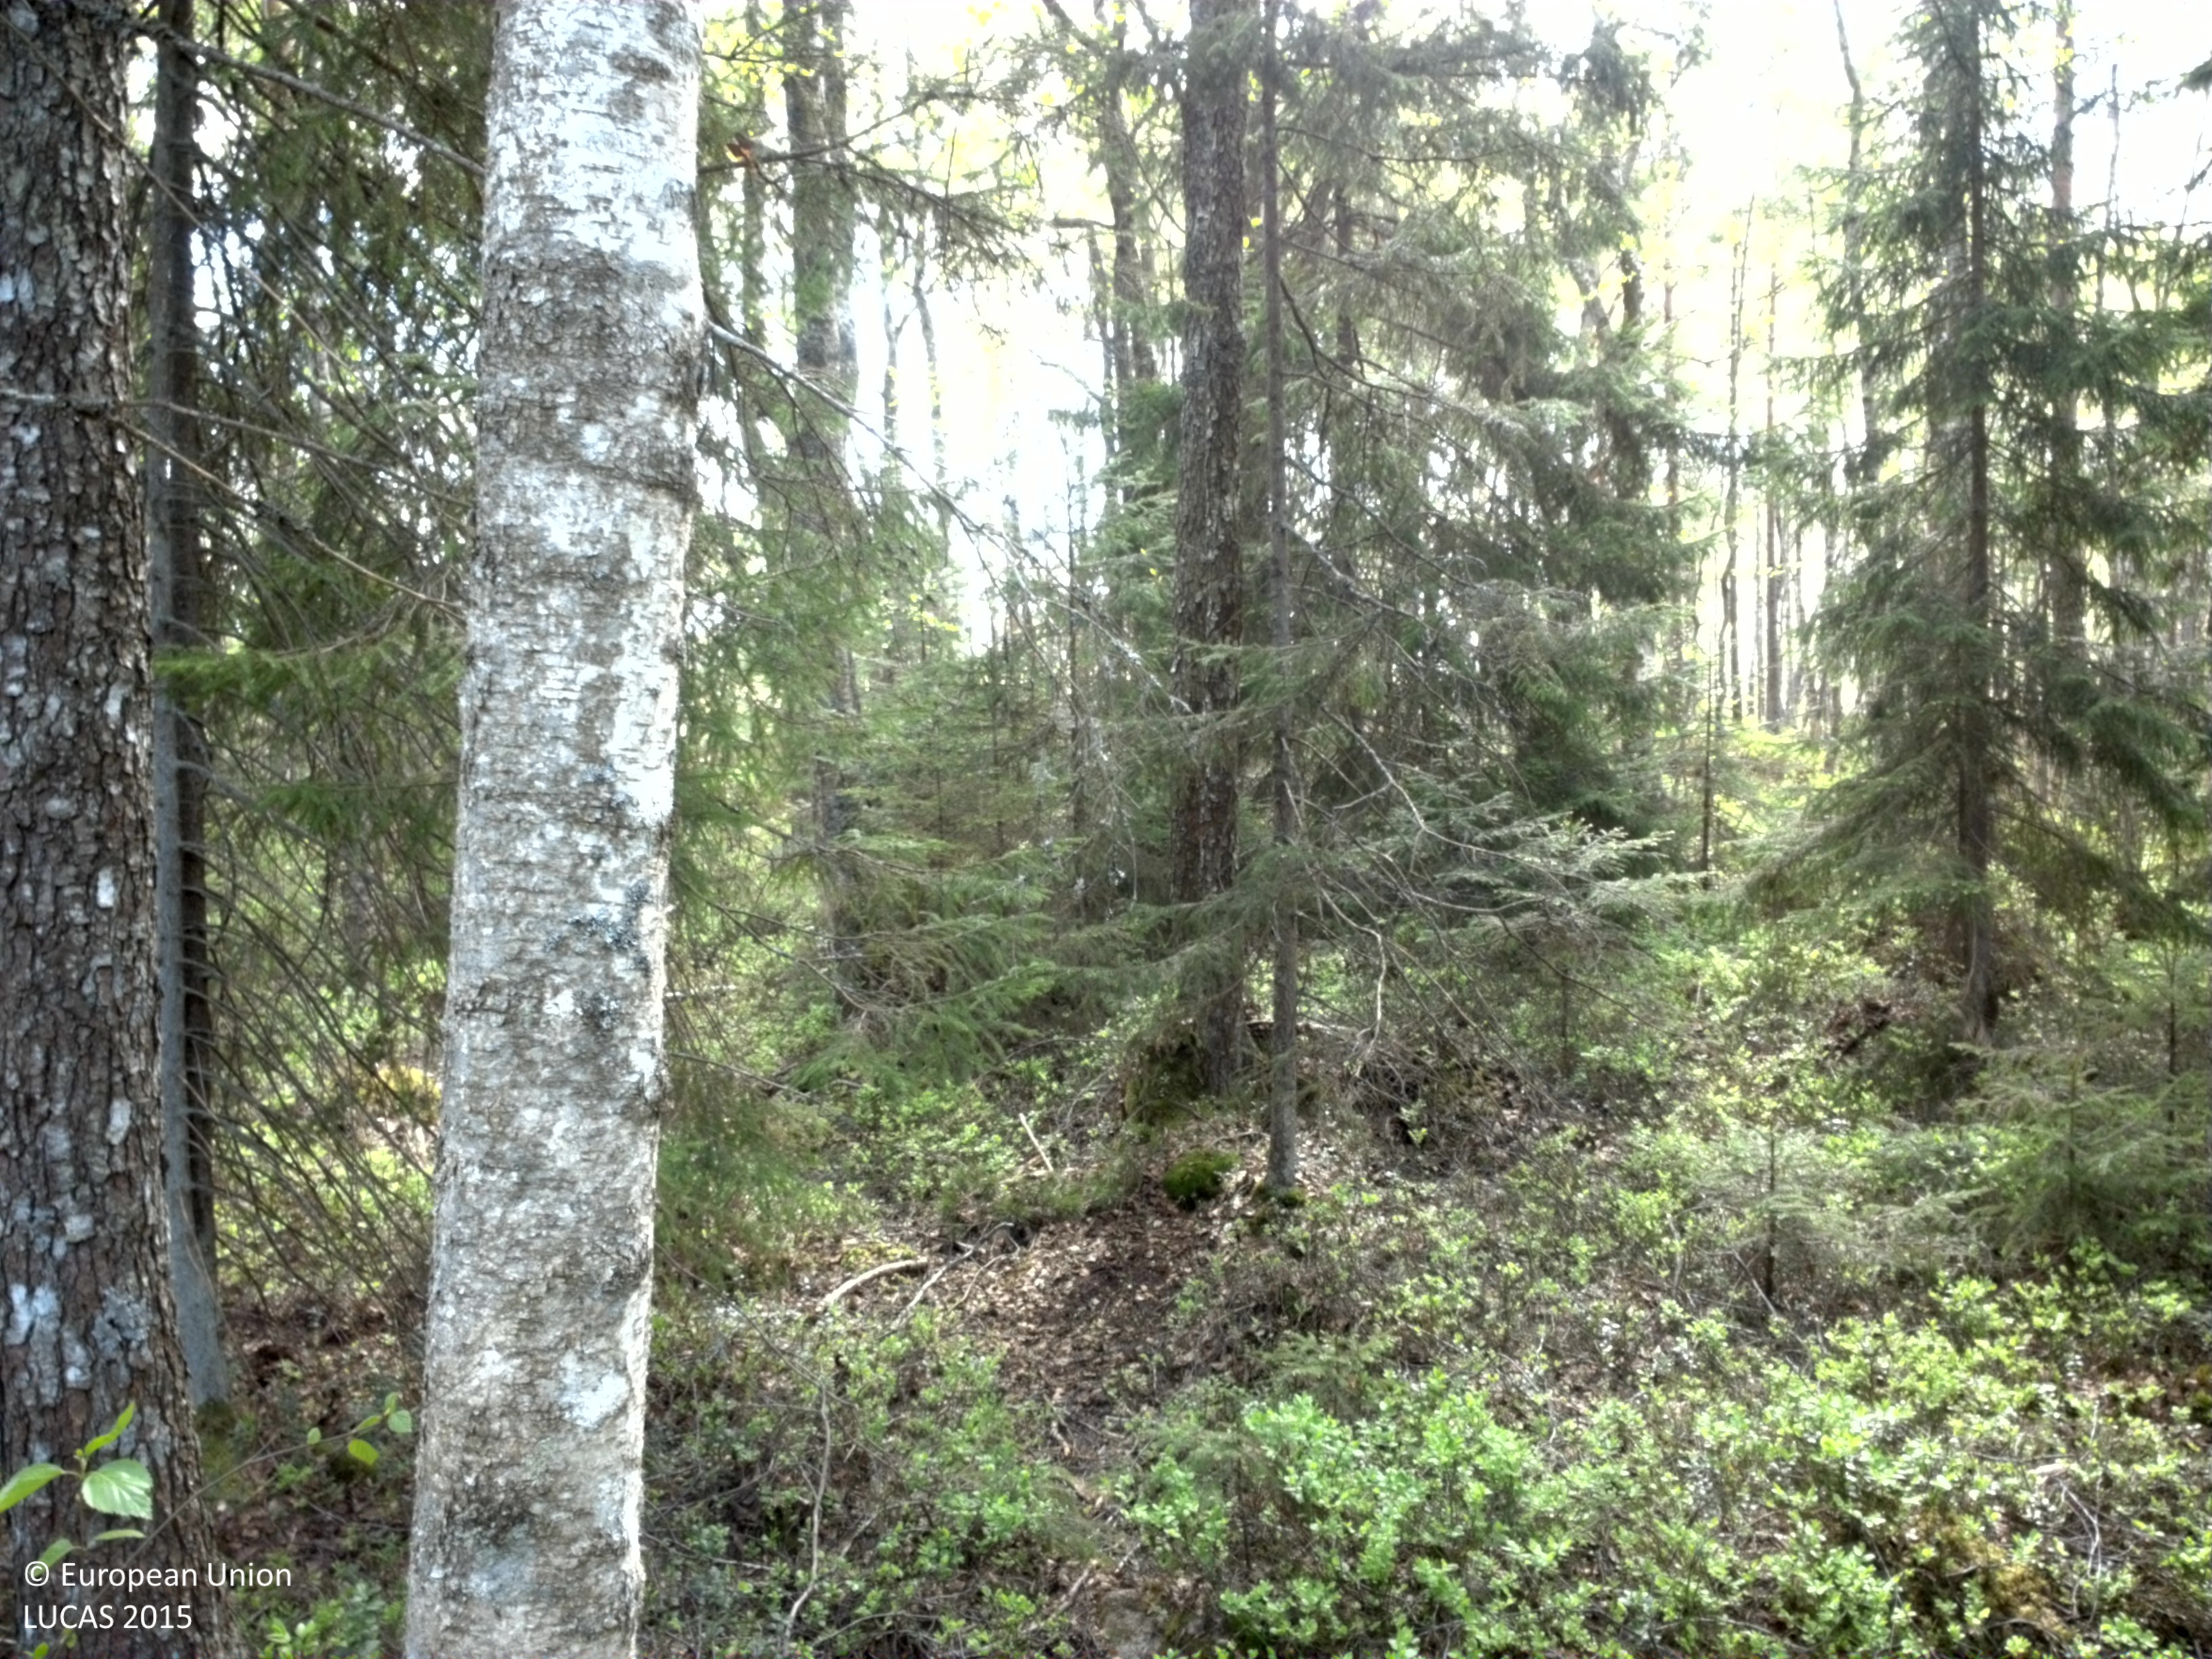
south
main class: Woodland
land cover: Spruce dominated mixed woodland
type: boreal forest
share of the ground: 50 - 75 %
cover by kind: broadleaved forest trees 50 %, coniferous forest trees 20 %, lichens and mosses 20 %, herbaceous plants 10 %
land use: Forestry
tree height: > 5 m
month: May
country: SE
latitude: 56.7512
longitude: 15.1493
